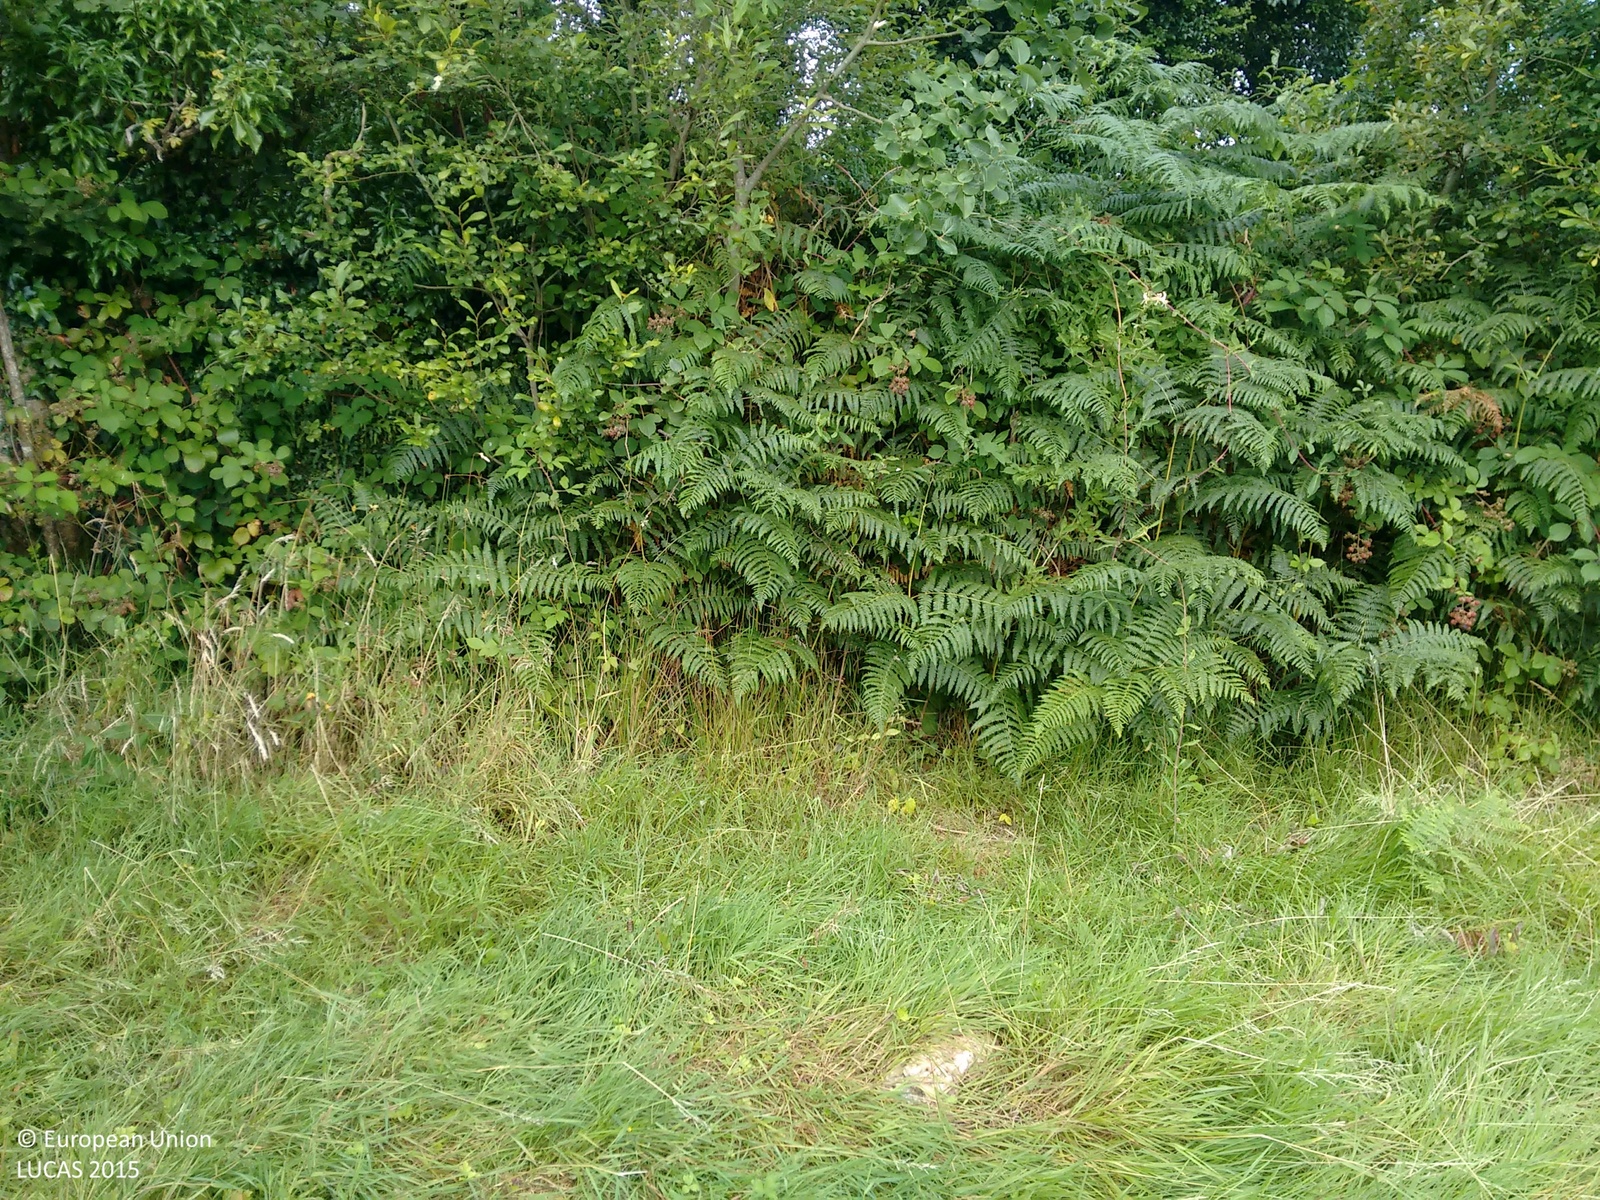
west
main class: Grassland
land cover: Grassland without tree/shrub cover
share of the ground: > 75 %
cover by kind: herbaceous plants 100 %
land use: Agriculture (excluding fallow land and kitchen gardens)
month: August
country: IE
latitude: 52.5129
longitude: -6.6503
